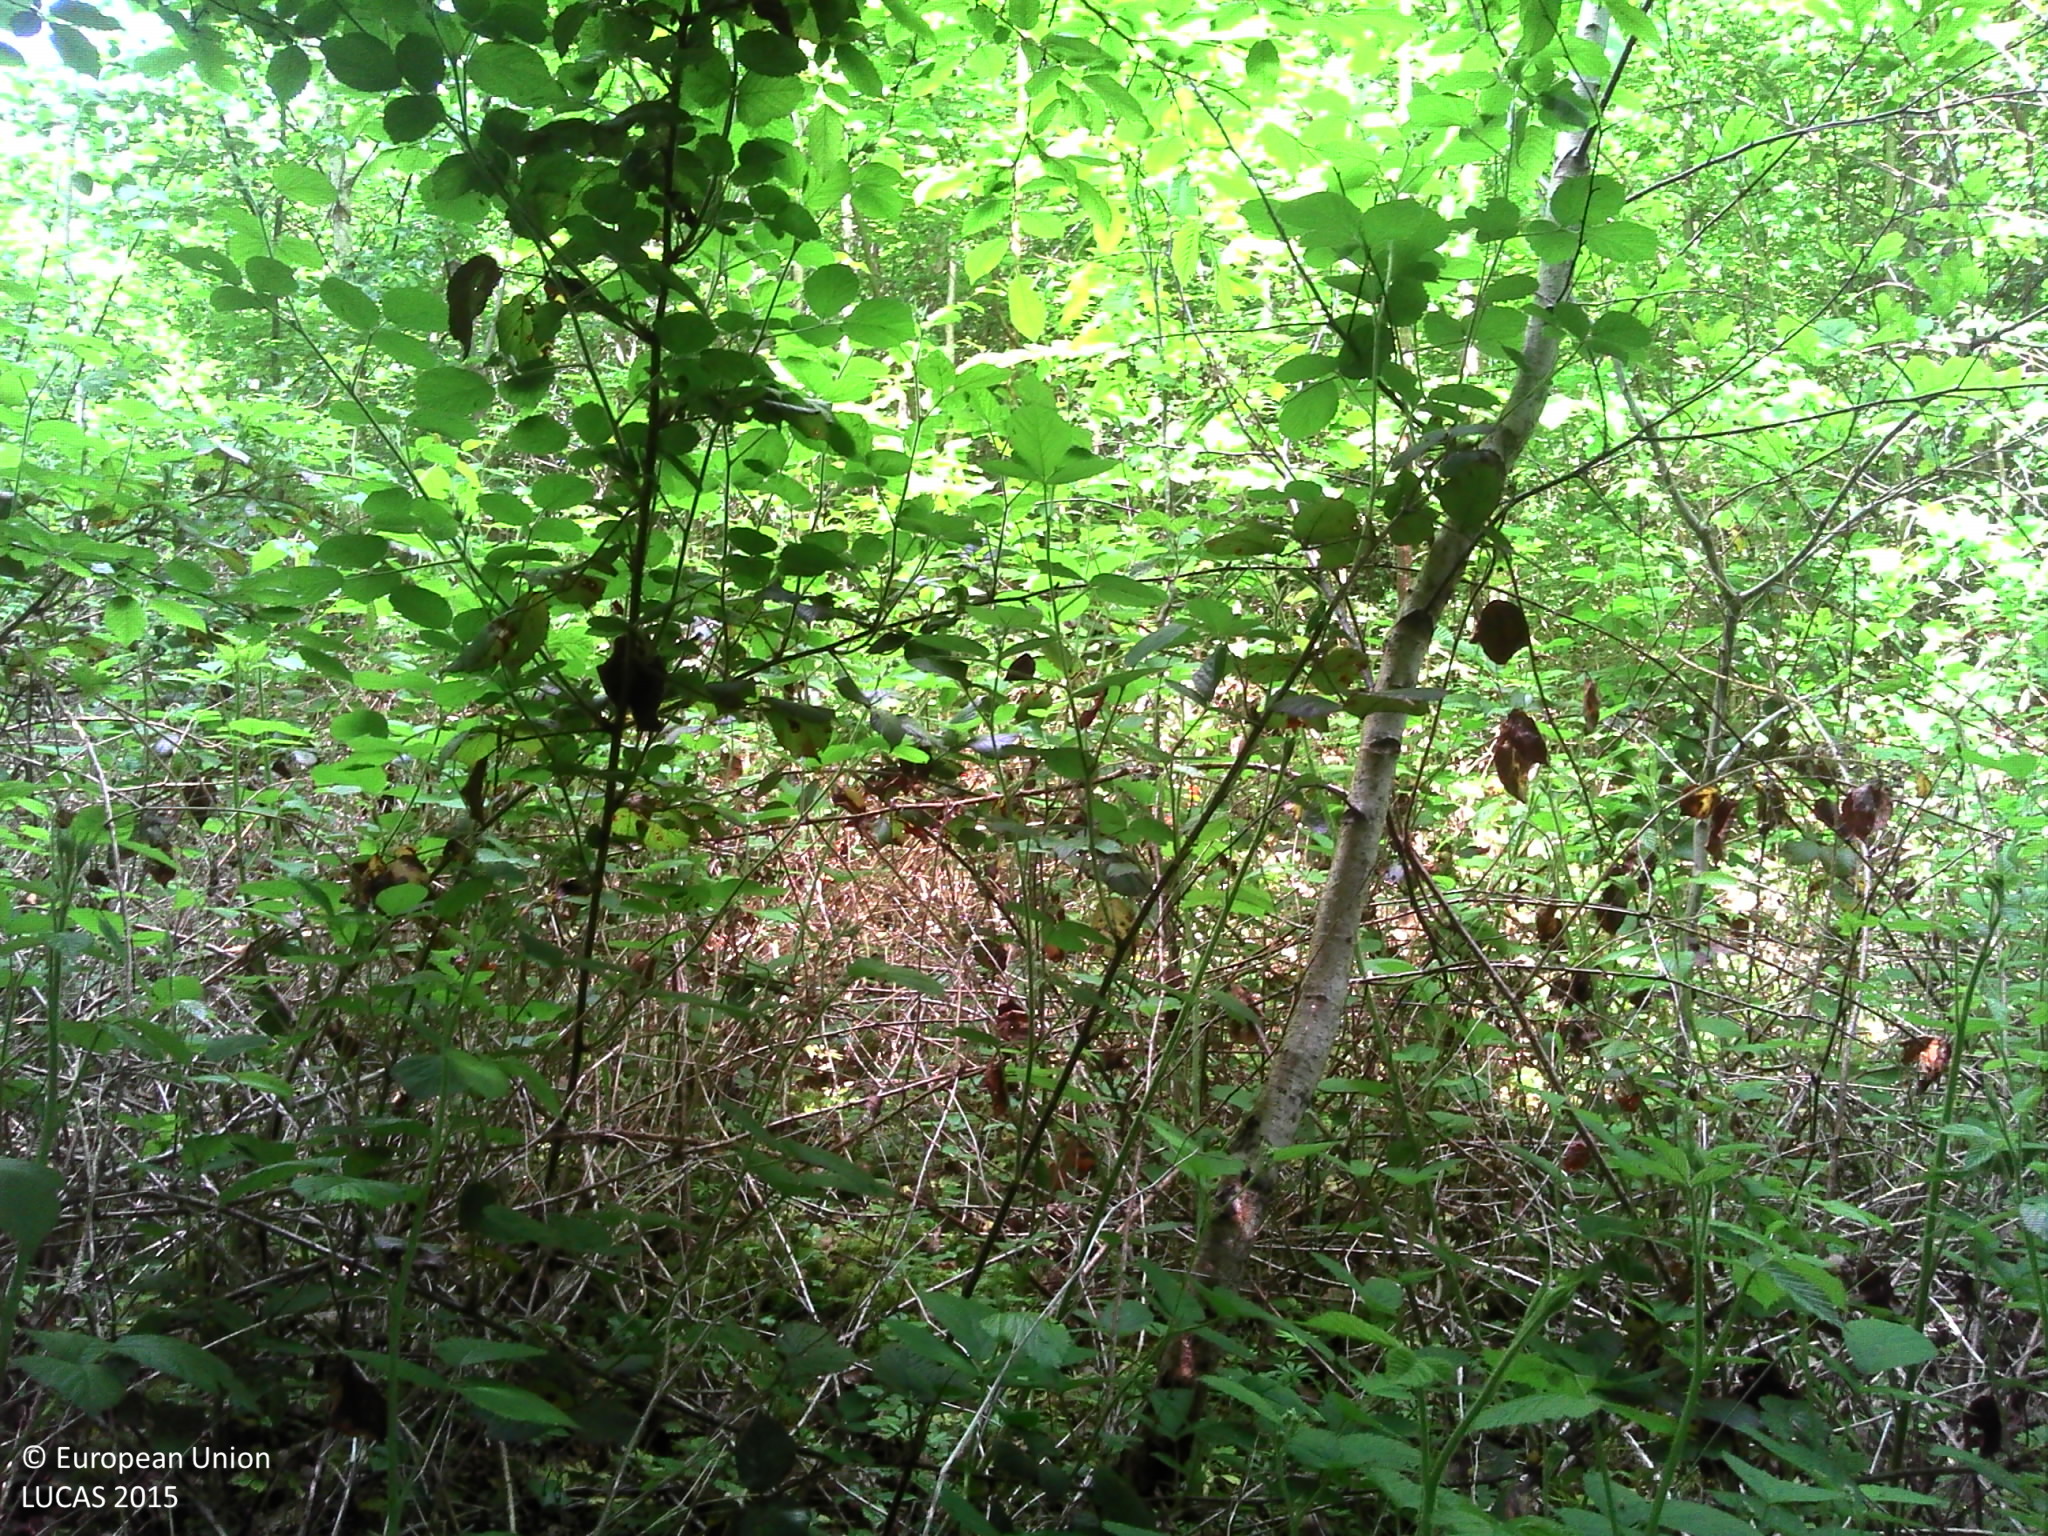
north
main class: Woodland
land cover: Broadleaved woodland
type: mesophytic deciduous forest
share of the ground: > 75 %
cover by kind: broadleaved forest trees 90 %, herbaceous plants 5 %, lichens and mosses 5 %
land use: Forestry
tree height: > 5 m
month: May
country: FR
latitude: 47.7888
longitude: 4.3250
